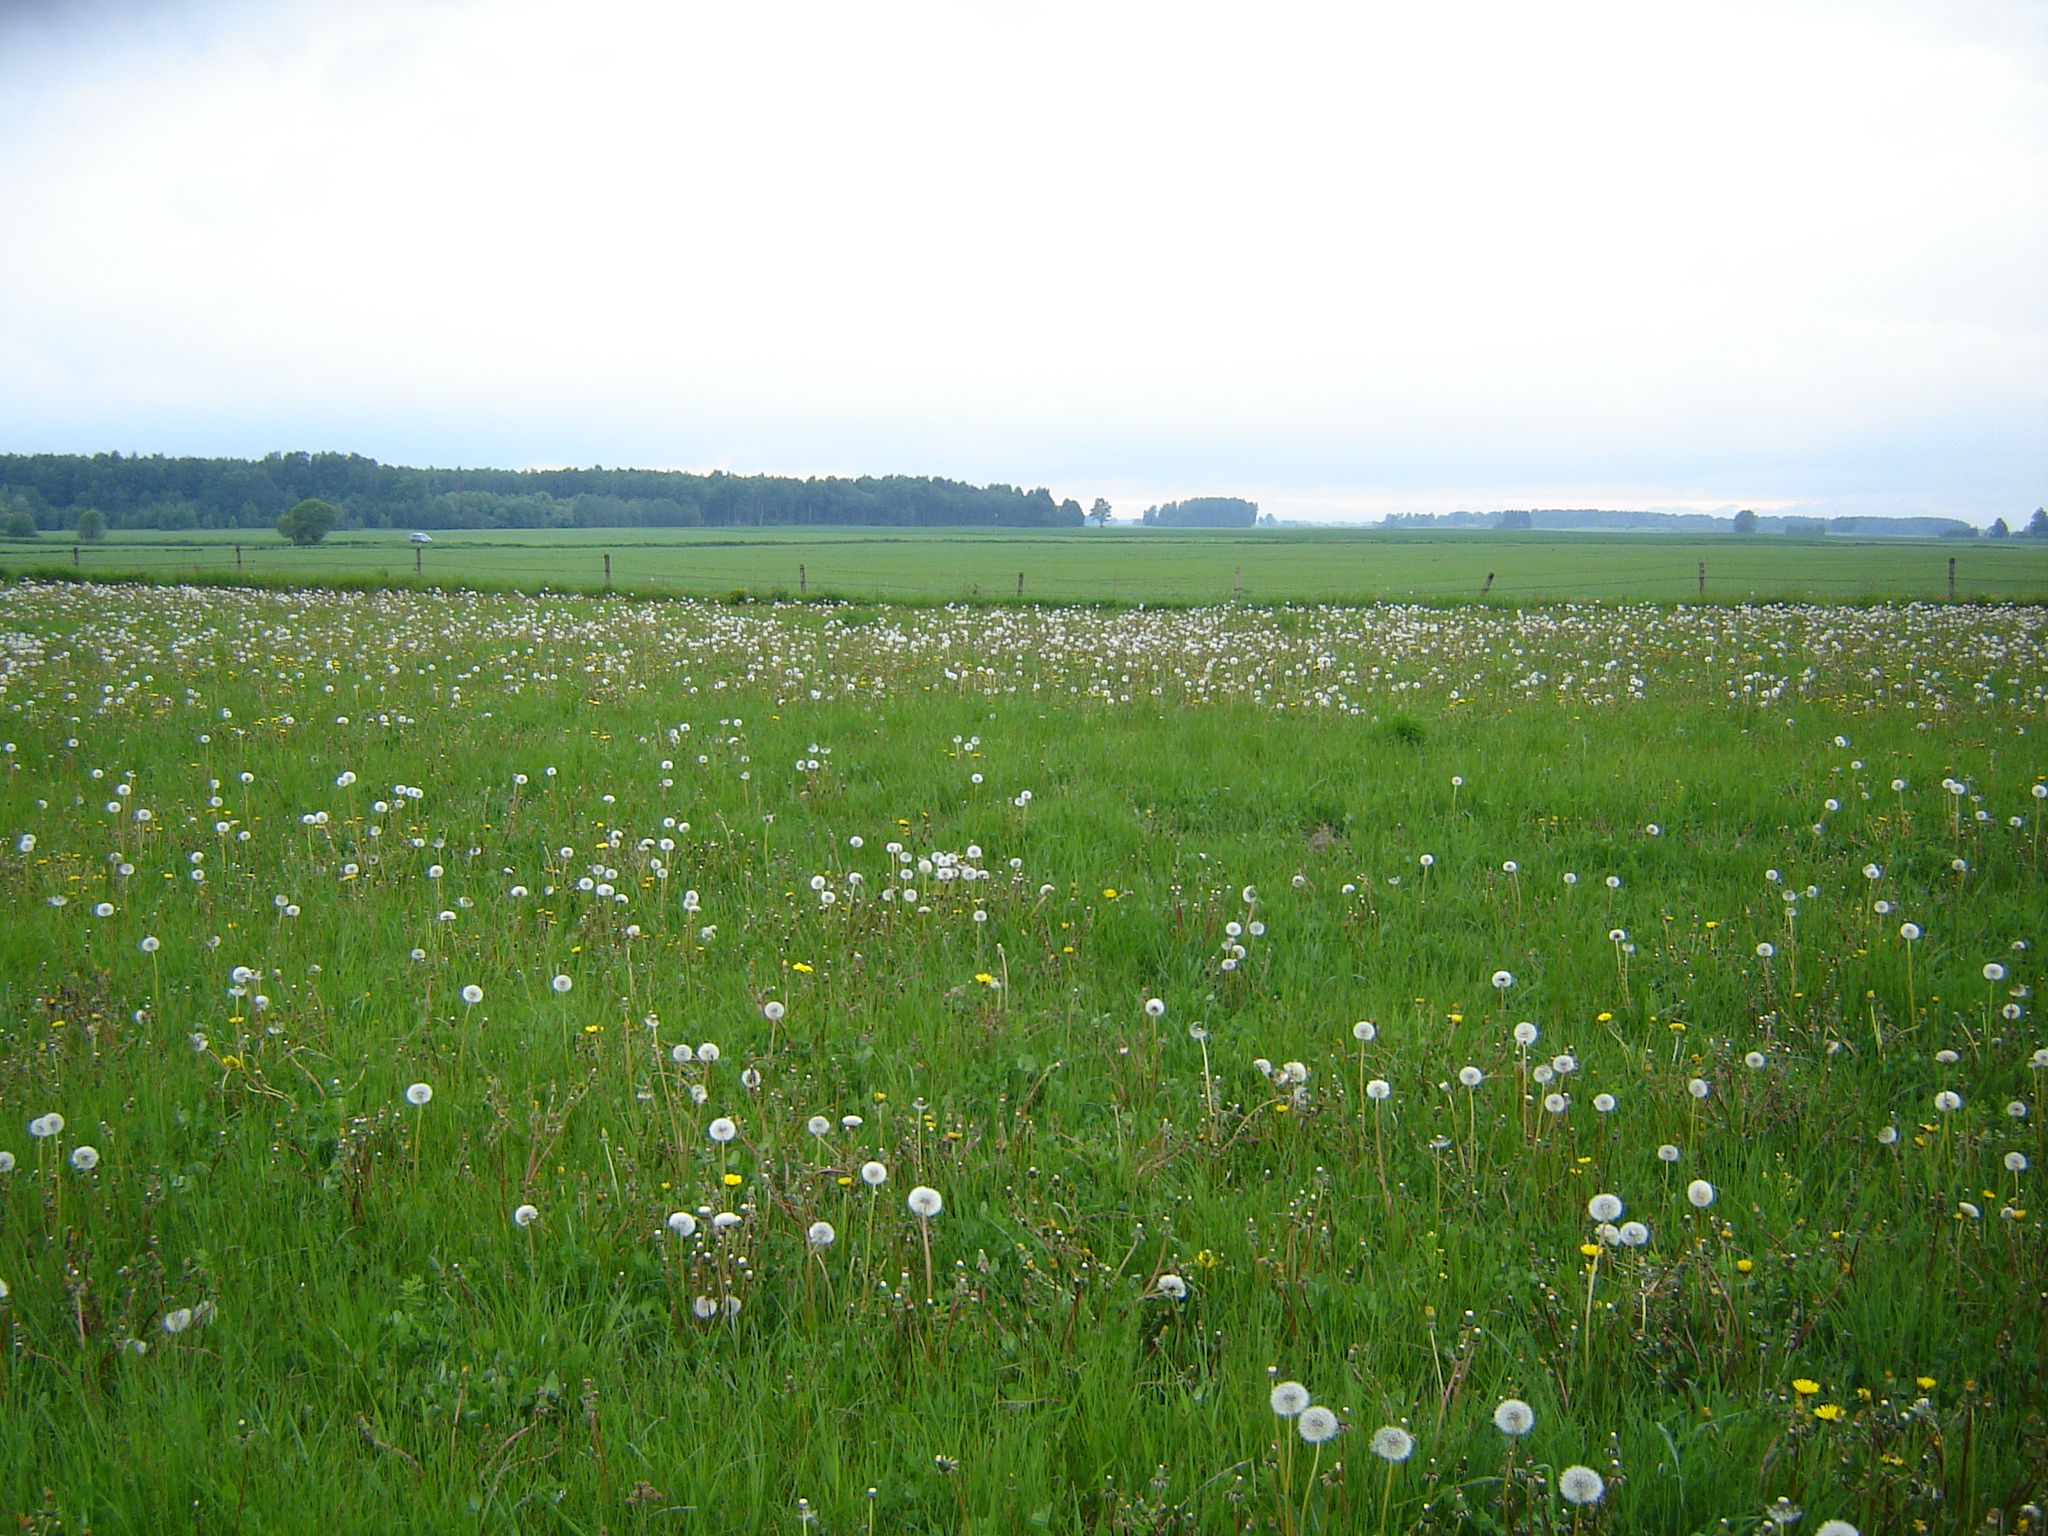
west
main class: Grassland
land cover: Grassland without tree/shrub cover
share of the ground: > 75 %
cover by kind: herbaceous plants 100 %
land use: Agriculture (excluding fallow land and kitchen gardens)
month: May
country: LT
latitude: 55.9958
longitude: 25.3006
